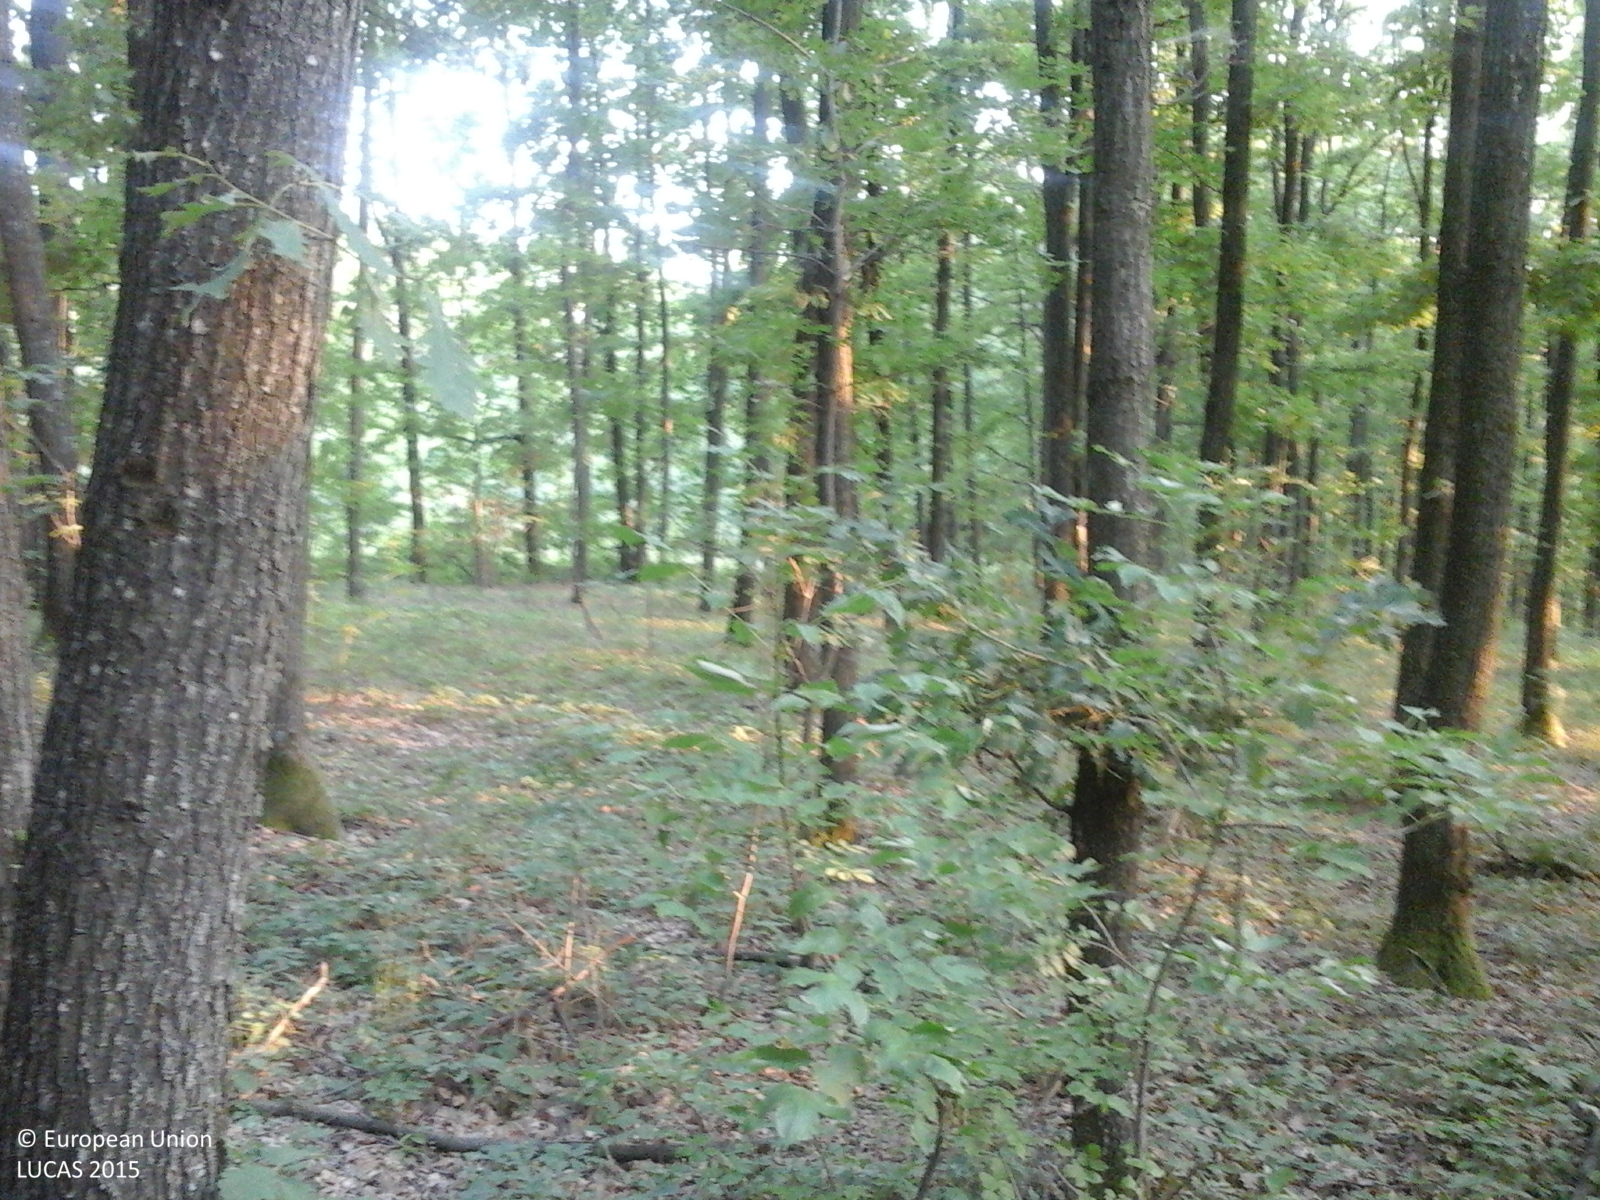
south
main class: Woodland
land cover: Broadleaved woodland
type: acidophilous oak and oak-birch forest
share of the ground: > 75 %
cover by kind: broadleaved forest trees 100 %
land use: Forestry
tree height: > 5 m
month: July
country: RO
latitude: 44.8469
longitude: 24.7428
